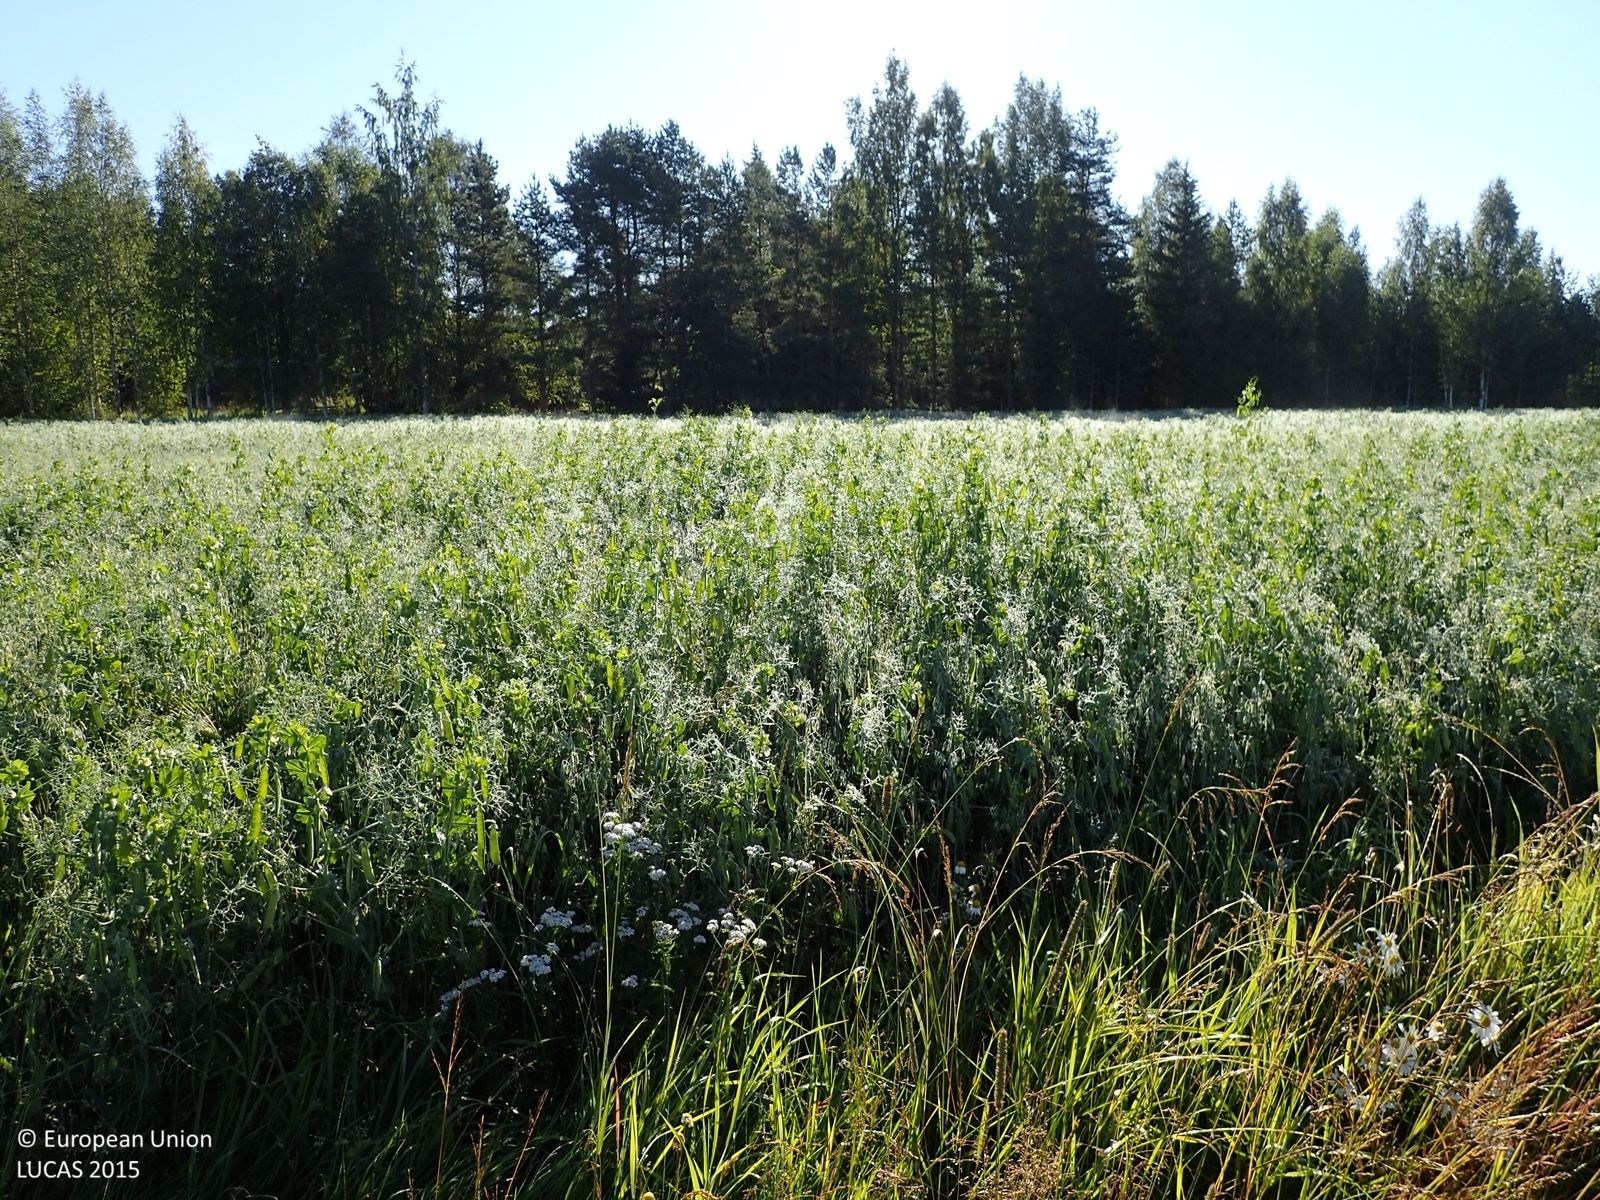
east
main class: Cropland
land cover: Barley
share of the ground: > 75 %
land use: Agriculture (excluding fallow land and kitchen gardens)
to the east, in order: Barley; Shruby margins; Ditches and canals; Shruby margins; Other leguminous and mixtures for fodder; Pine dominated mixed woodland; Artificial constructions in urban areas; Ditches and canals; Broadleaved woodland; Ditches and canals; Temporary grasslands; Ditches and canals; Oats
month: August
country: FI
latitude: 62.5804
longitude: 22.5326
